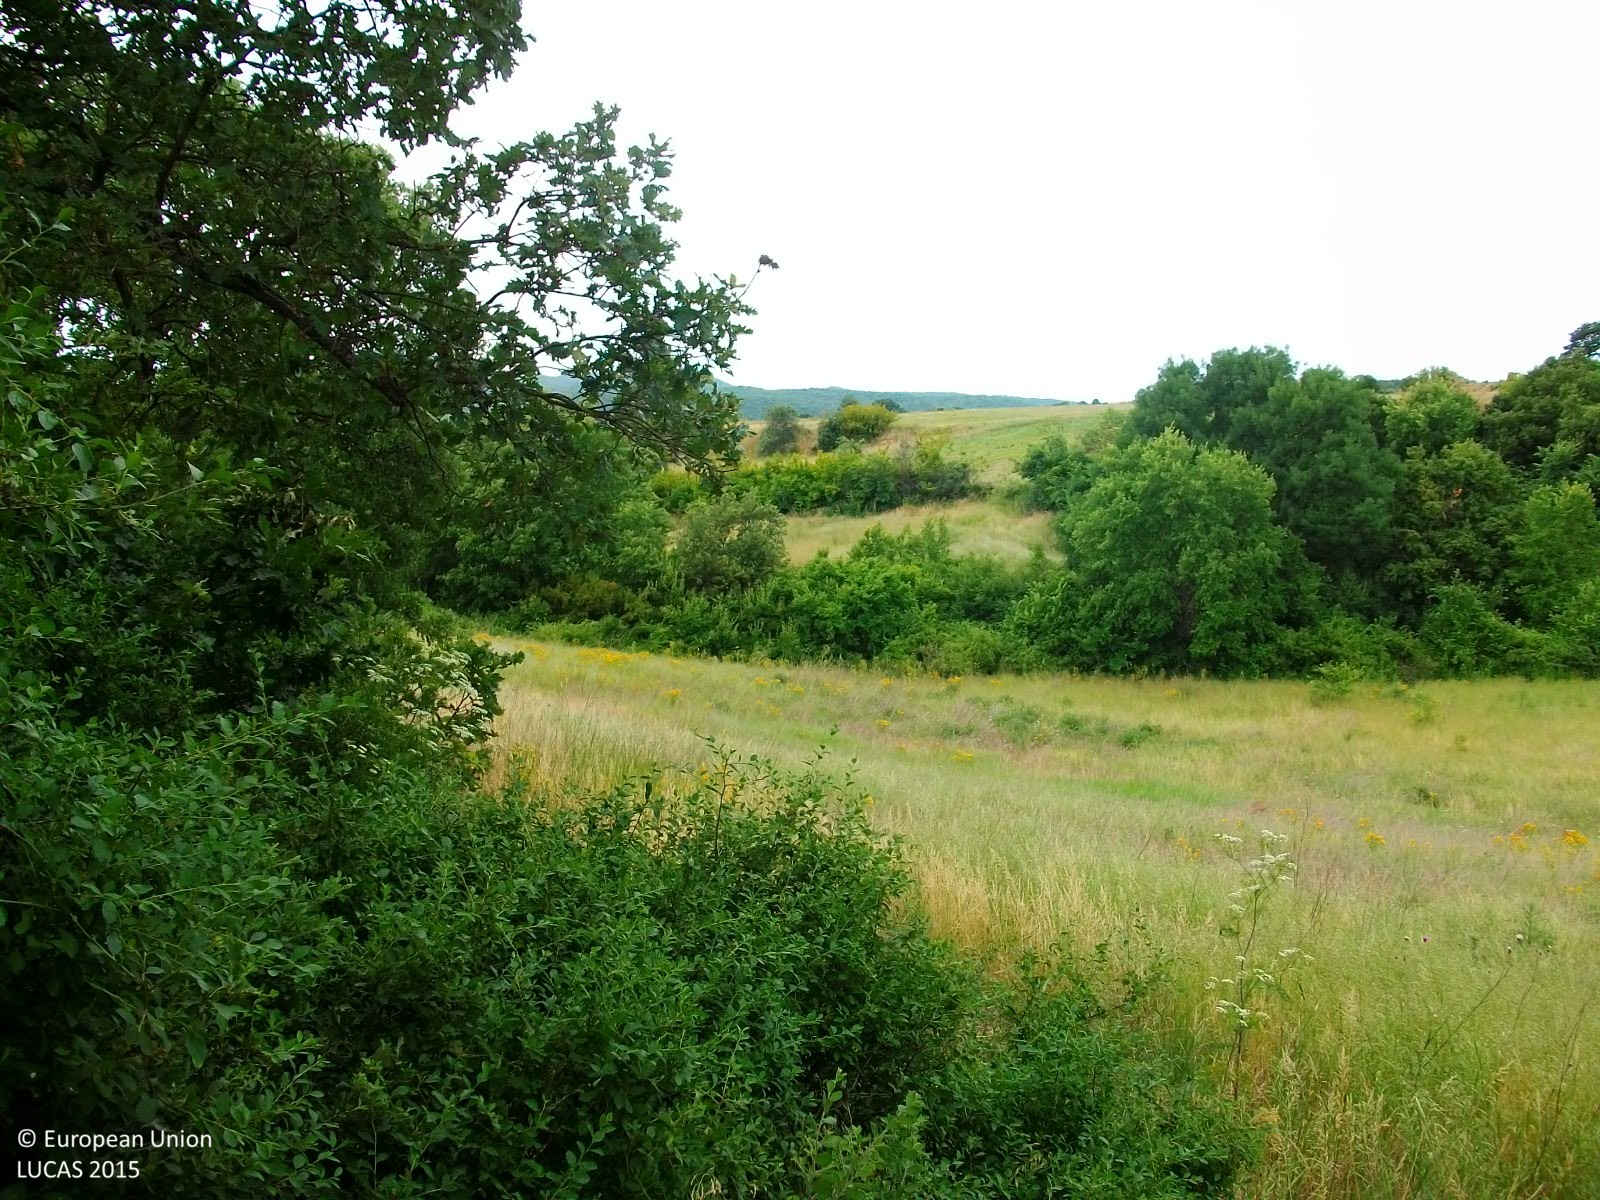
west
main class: Woodland
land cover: Broadleaved woodland
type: thermophilous deciduous forest
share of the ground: 50 - 75 %
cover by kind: broadleaved forest trees 60 %, shrubs 20 %, herbaceous plants 20 %
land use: Semi-natural and natural areas not in use
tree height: > 5 m
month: June
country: GR
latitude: 41.7166
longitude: 26.1440
